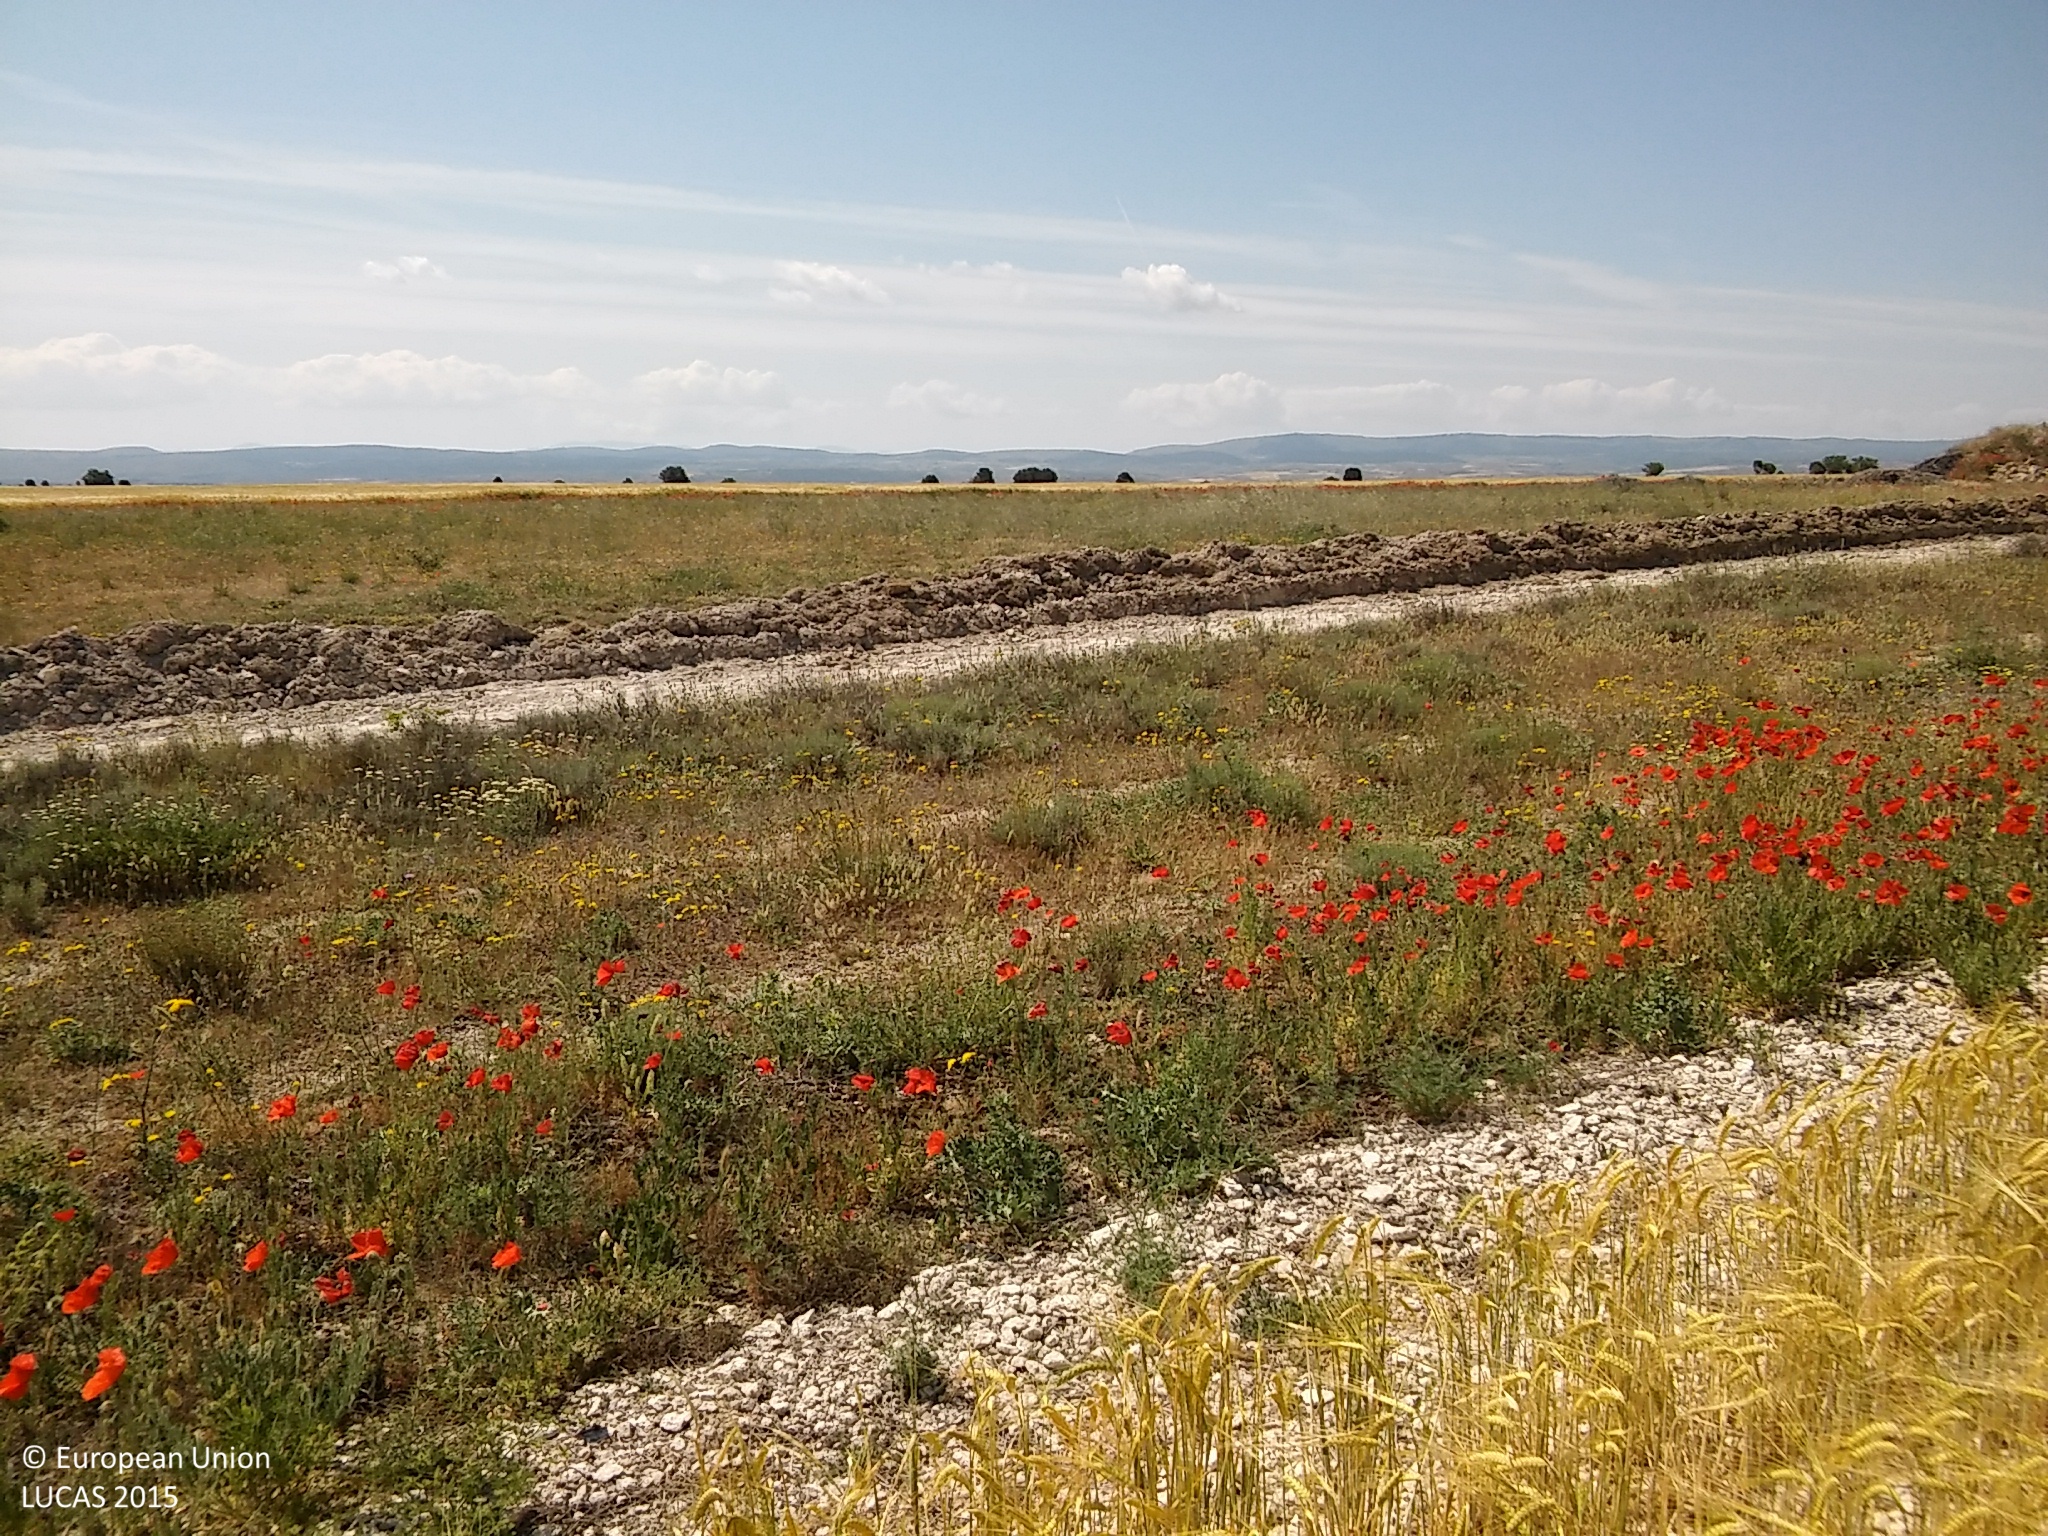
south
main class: Cropland
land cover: Barley
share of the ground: > 75 %
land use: Agriculture (excluding fallow land and kitchen gardens)
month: June
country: ES
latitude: 41.6202
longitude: -3.7470
